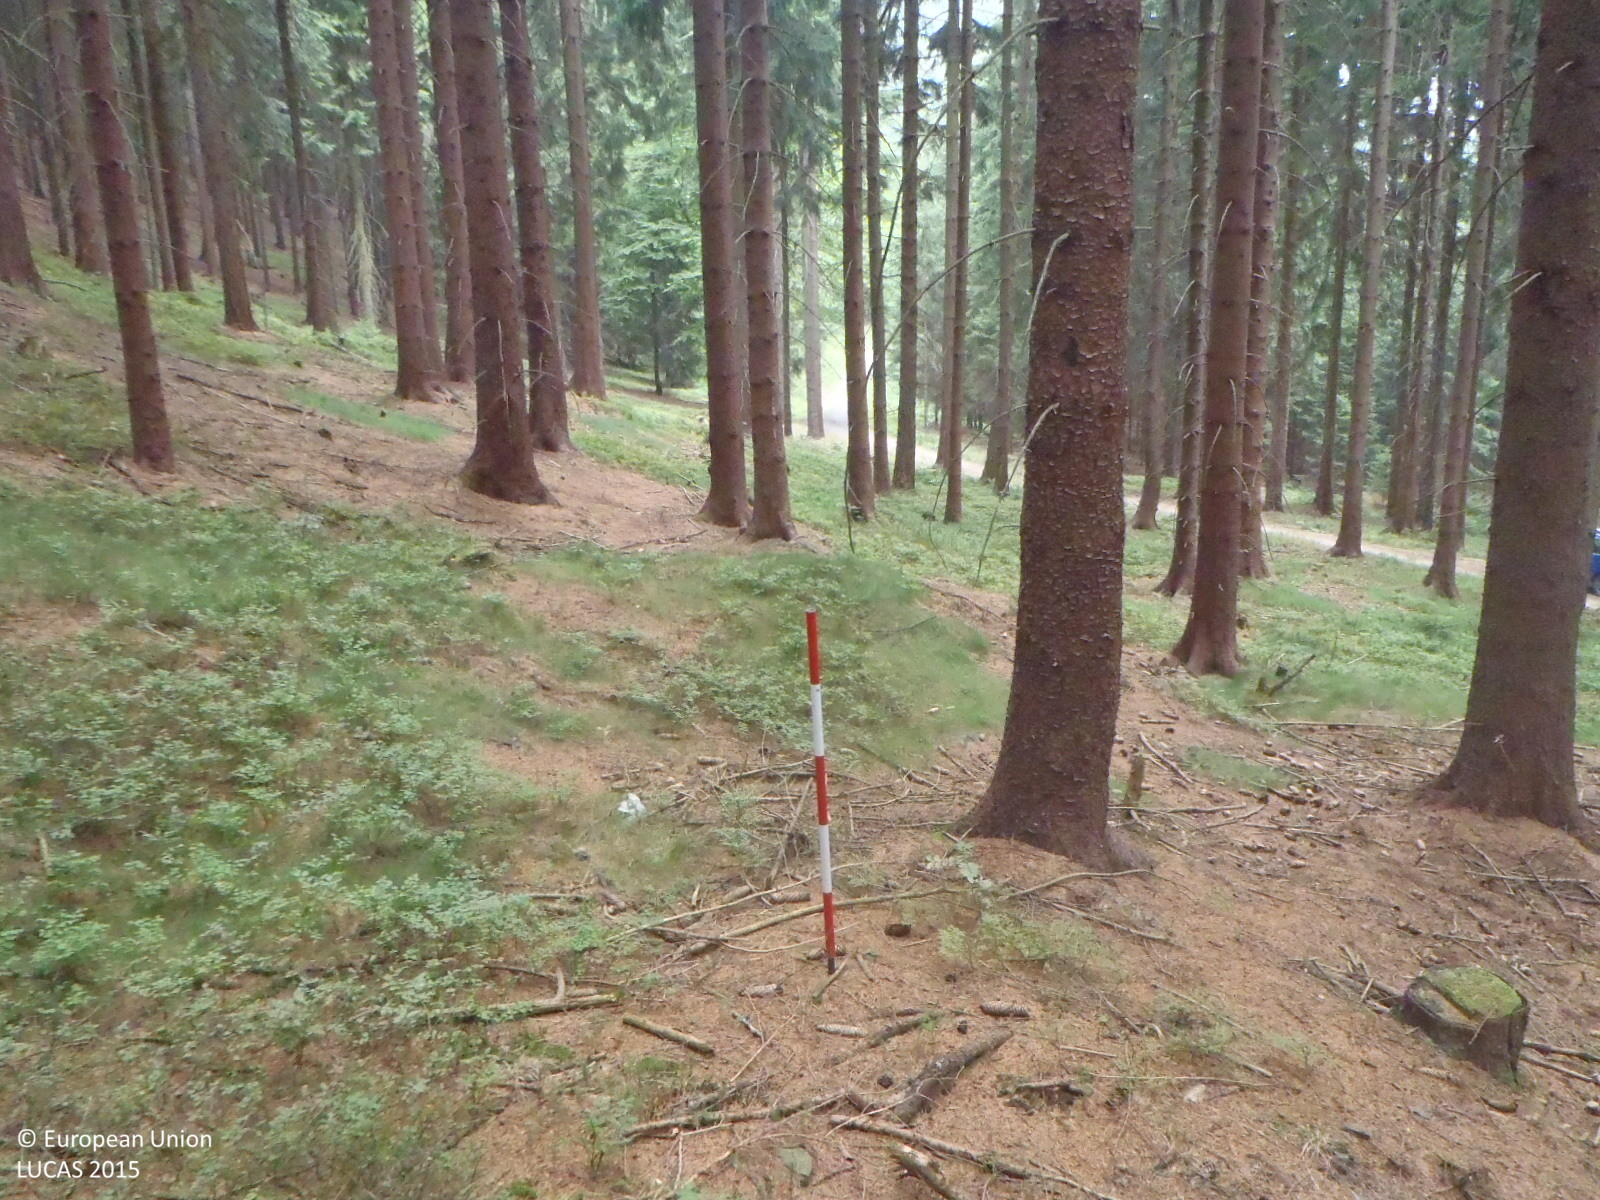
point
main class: Woodland
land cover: Spruce dominated coniferous woodland
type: hemiboreal forest and nemoral coniferous forest and mixed broadleaved-coniferous forest
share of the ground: > 75 %
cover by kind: coniferous forest trees 100 %
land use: Forestry
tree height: > 5 m
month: August
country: CZ
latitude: 50.7601
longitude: 14.9788
